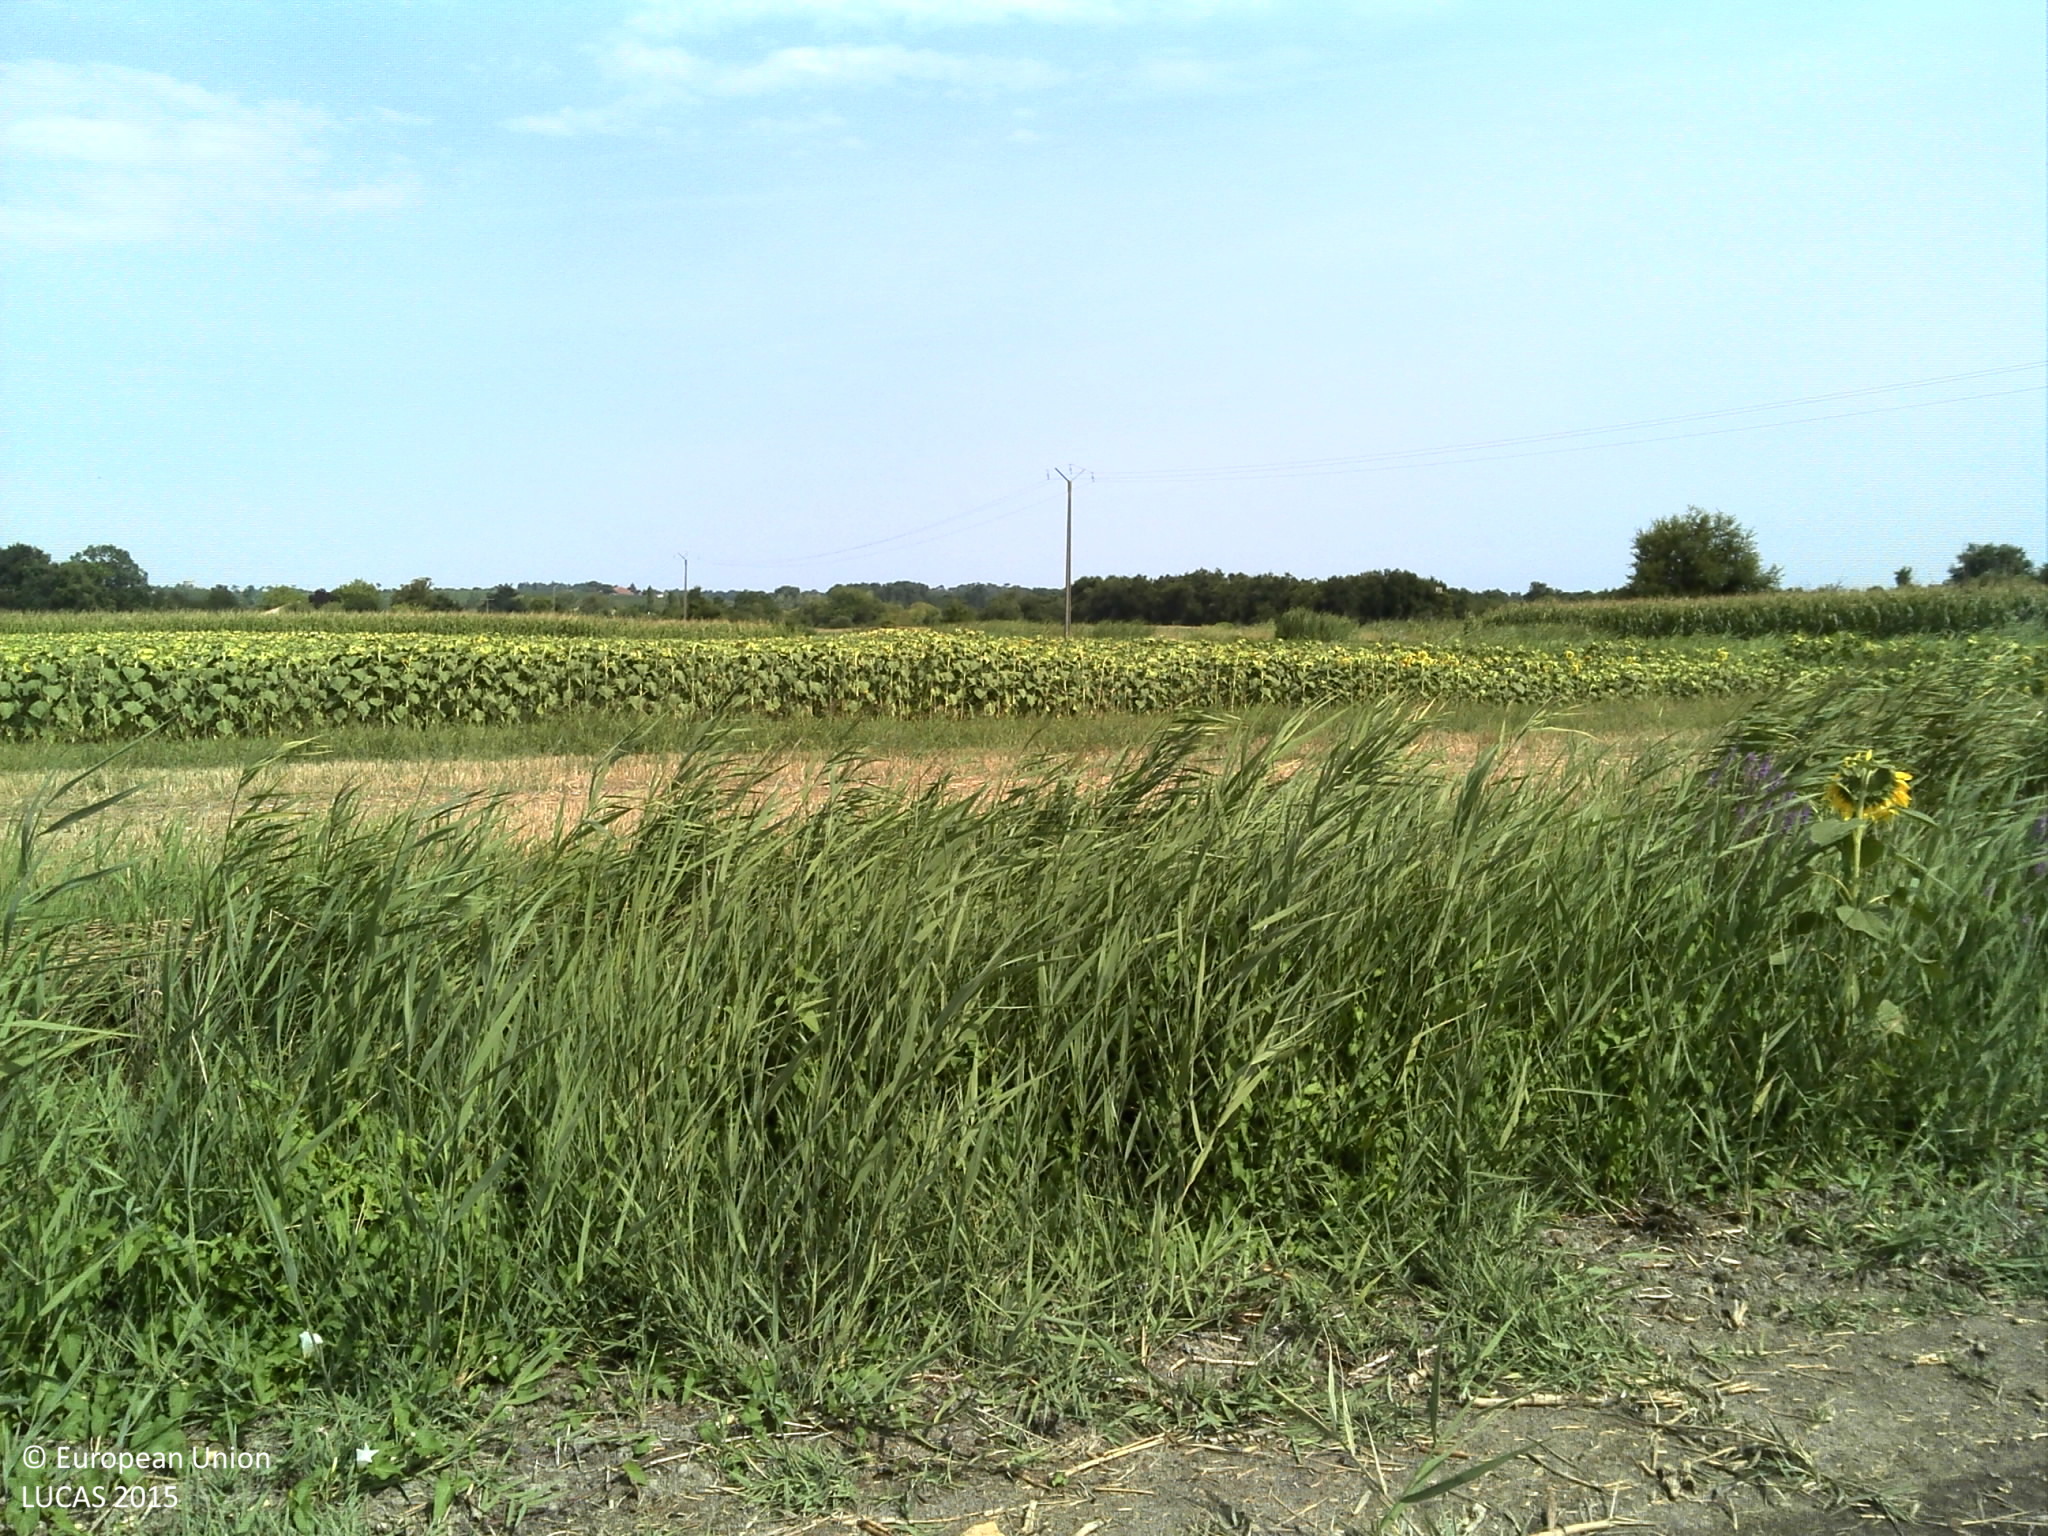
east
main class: Cropland
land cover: Sunflower
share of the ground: > 75 %
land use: Agriculture (excluding fallow land and kitchen gardens)
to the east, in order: Tracks; Ditches and canals; Grass margins; Tracks; Grass margins; Sunflower; Ditches and canals; Maize; Ditches and canals; Grass margins; Paved roads, cycling and walking lanes; Grass margins; Electric lines; Ditches and canals
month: August
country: FR
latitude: 45.3097
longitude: -0.6466
